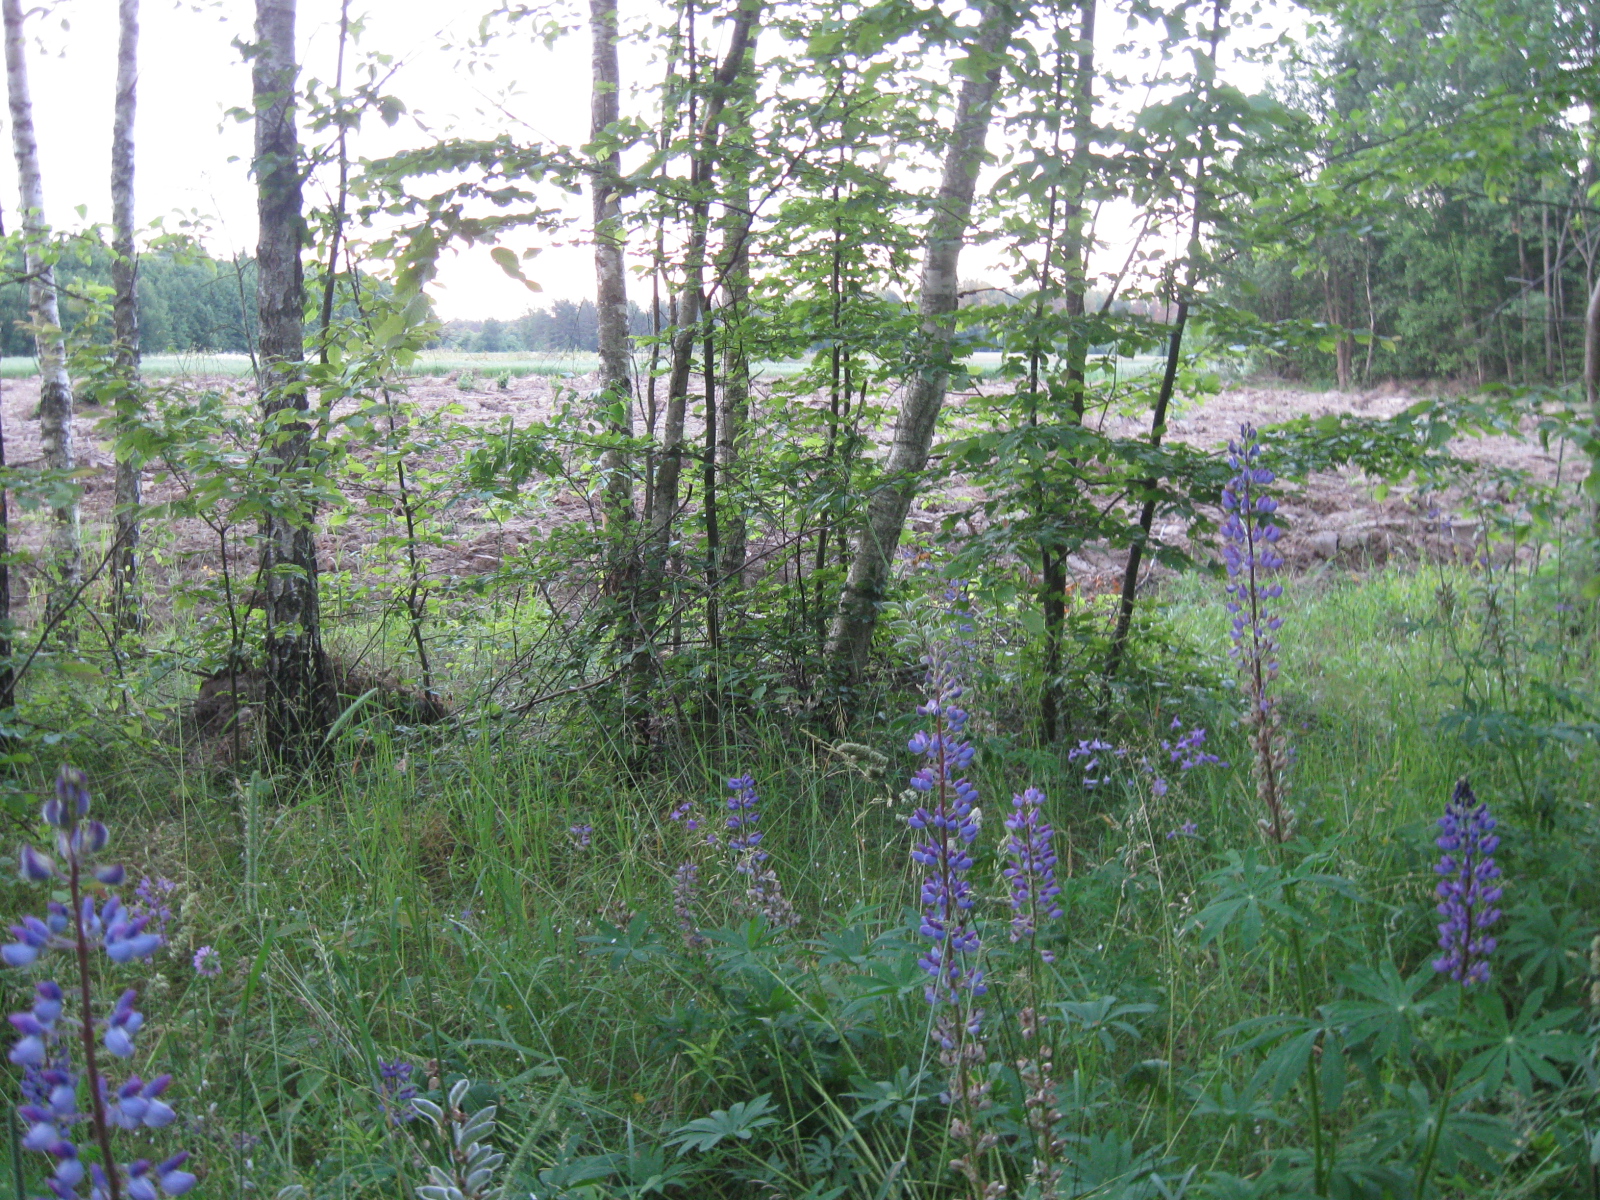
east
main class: Woodland
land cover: Broadleaved woodland
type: non-riverine alder, birch or aspen forest
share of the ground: 50 - 75 %
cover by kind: broadleaved forest trees 65 %, herbaceous plants 25 %, shrubs 10 %
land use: Forestry
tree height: > 5 m
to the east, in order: Broadleaved woodland; Other bare soil; Oats; Spontaneously vegetated surfaces; Oats
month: June
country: LT
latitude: 54.1274
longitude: 24.6914
